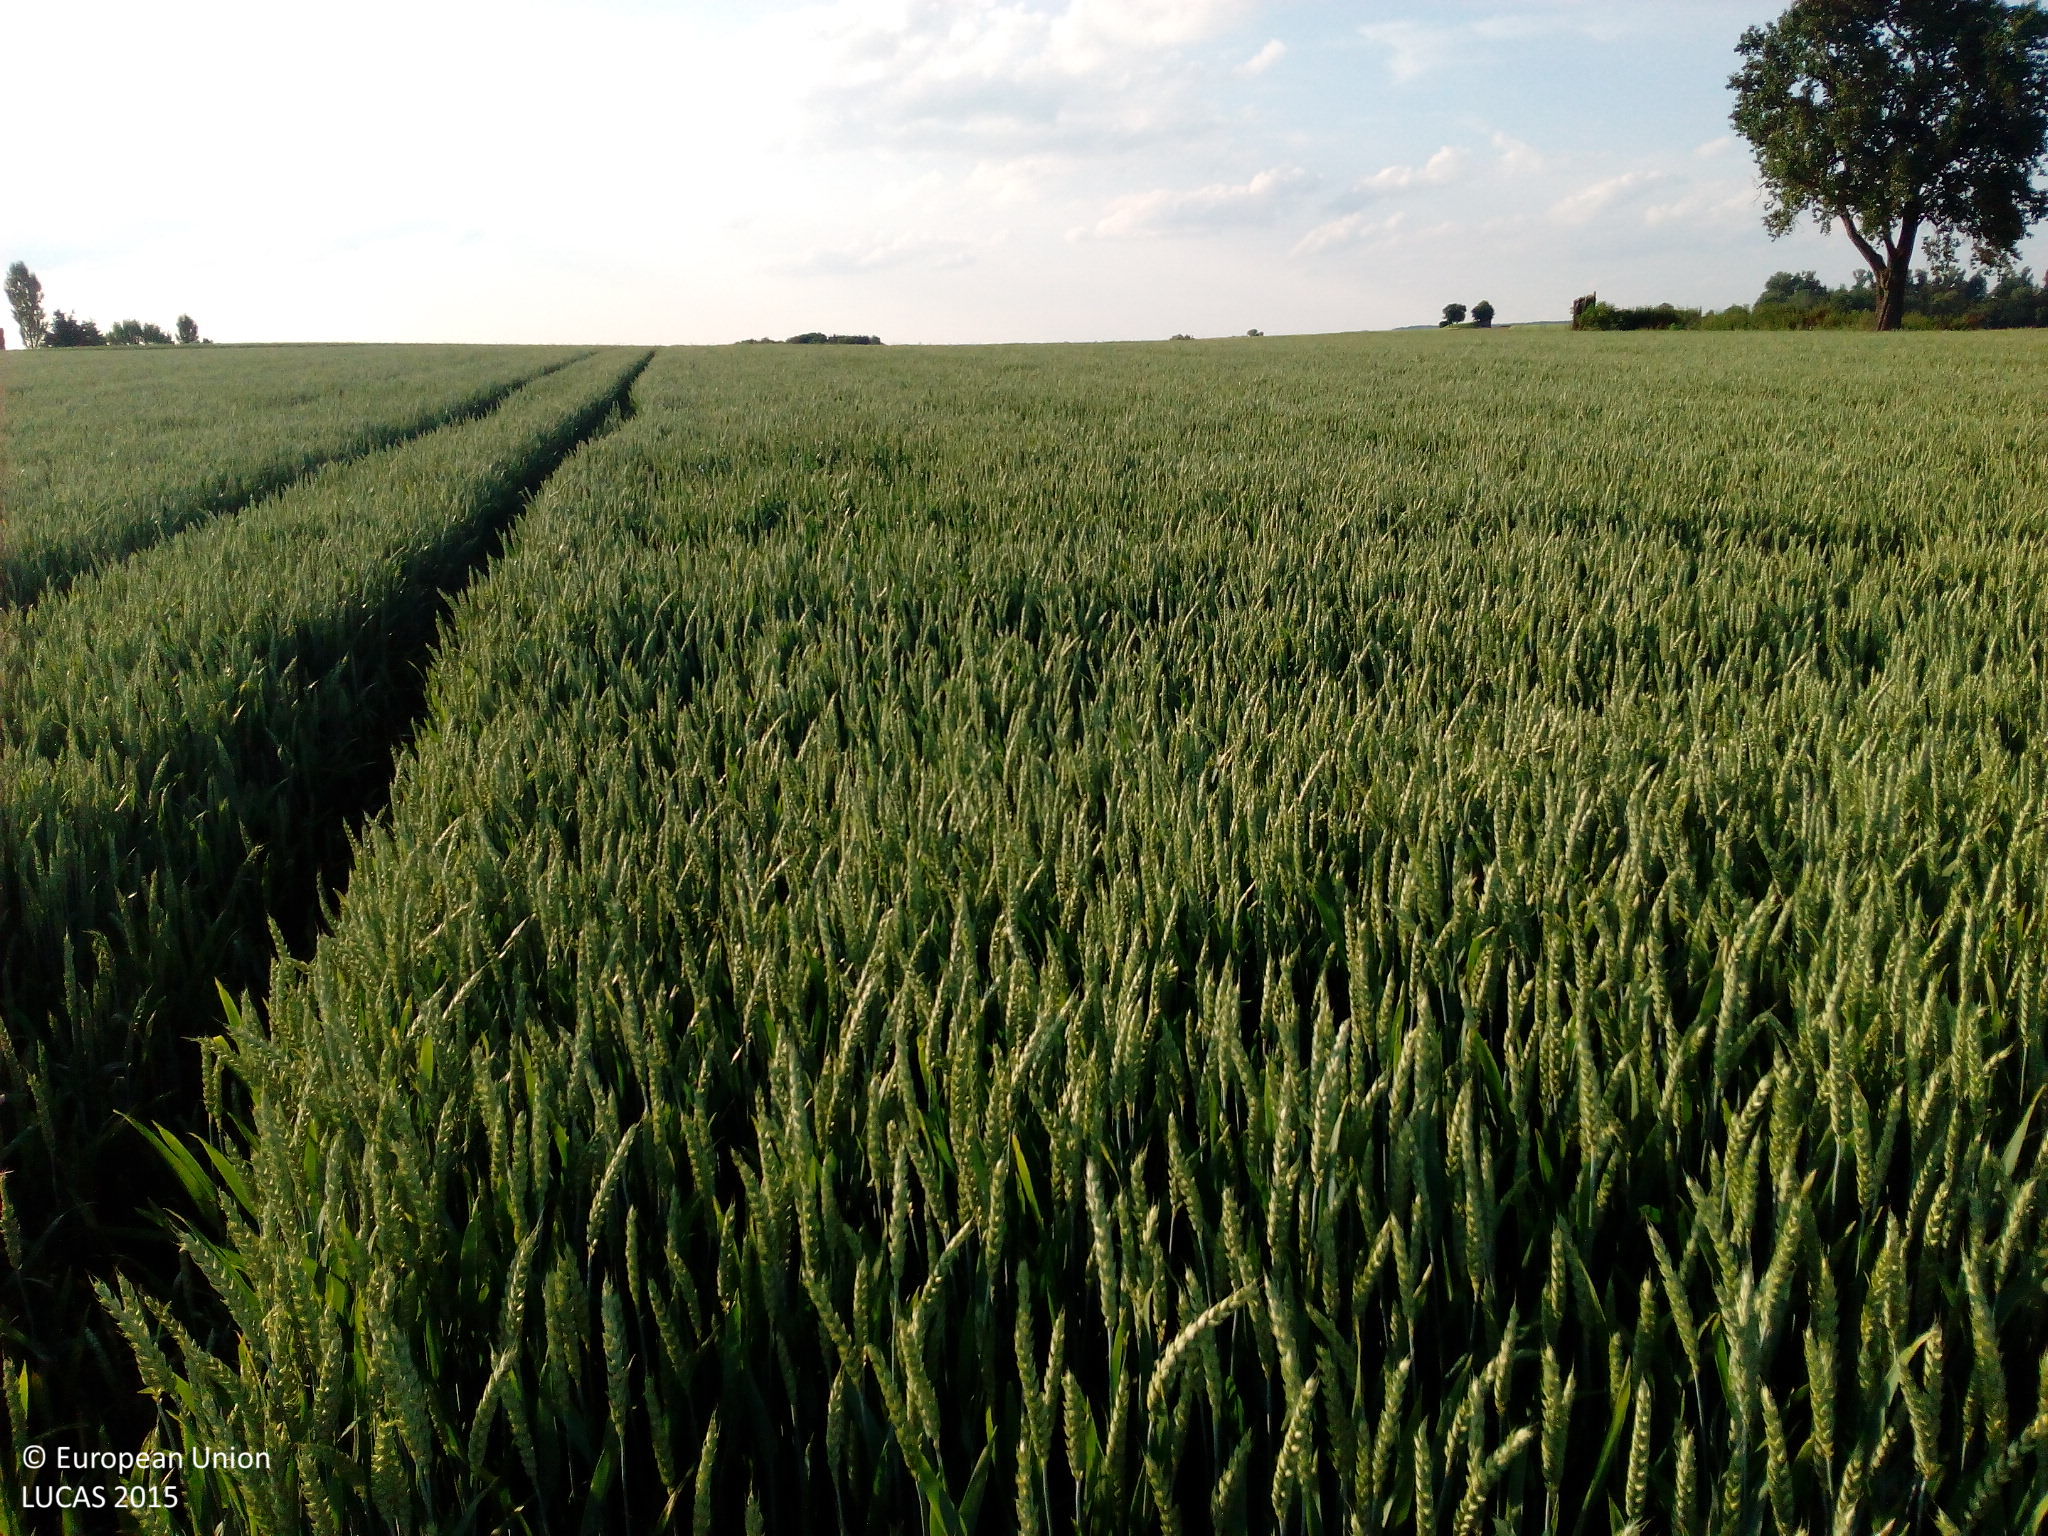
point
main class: Cropland
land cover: Common wheat
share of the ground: > 75 %
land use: Agriculture (excluding fallow land and kitchen gardens)
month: June
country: DE
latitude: 48.3134
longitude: 9.8518
